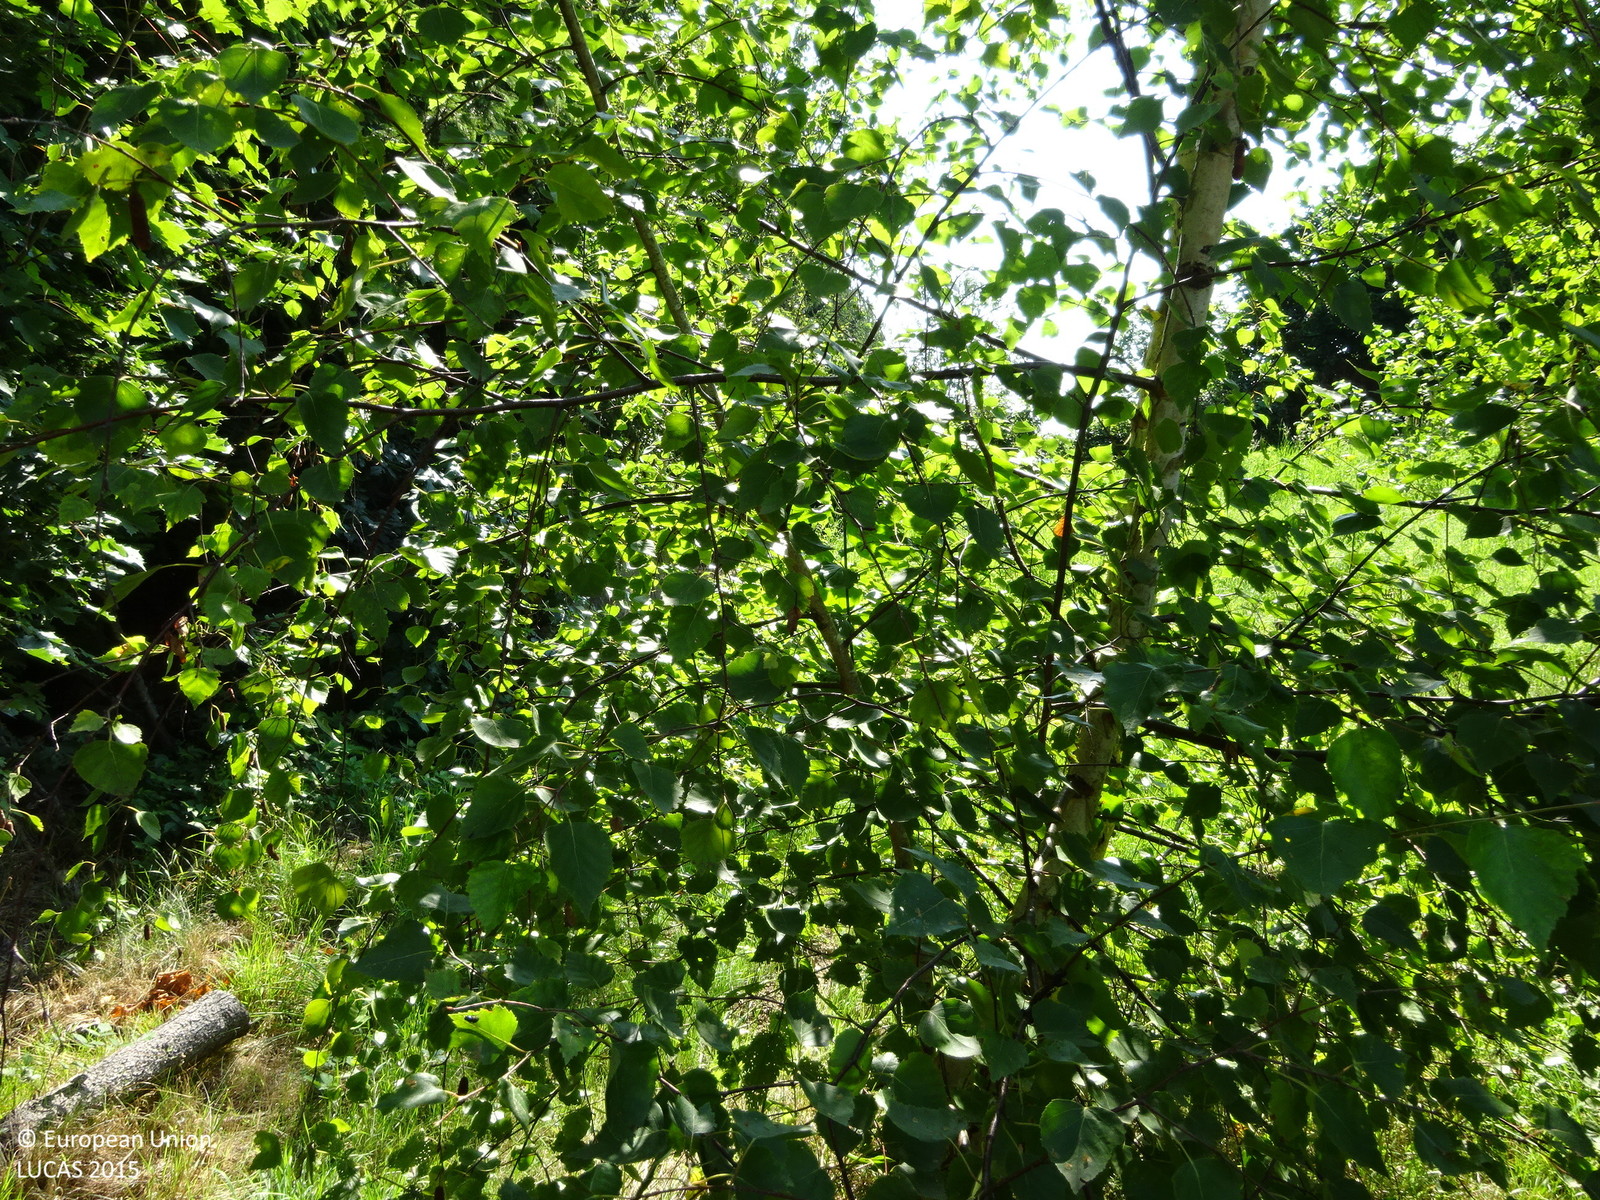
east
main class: Woodland
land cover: Broadleaved woodland
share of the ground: 25 - 50 %
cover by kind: herbaceous plants 55 %, broadleaved forest trees 25 %, unconsolidated bare surface 20 %
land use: Residential
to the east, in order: Broadleaved woodland; Spruce dominated mixed woodland; Fences; Broadleaved woodland; Grassland without tree/shrub cover; Artificial constructions in urban areas; Grassland without tree/shrub cover; Paved roads, cycling and walking lanes; Grassland without tree/shrub cover
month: August
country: AT
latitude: 47.3937
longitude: 15.9770
